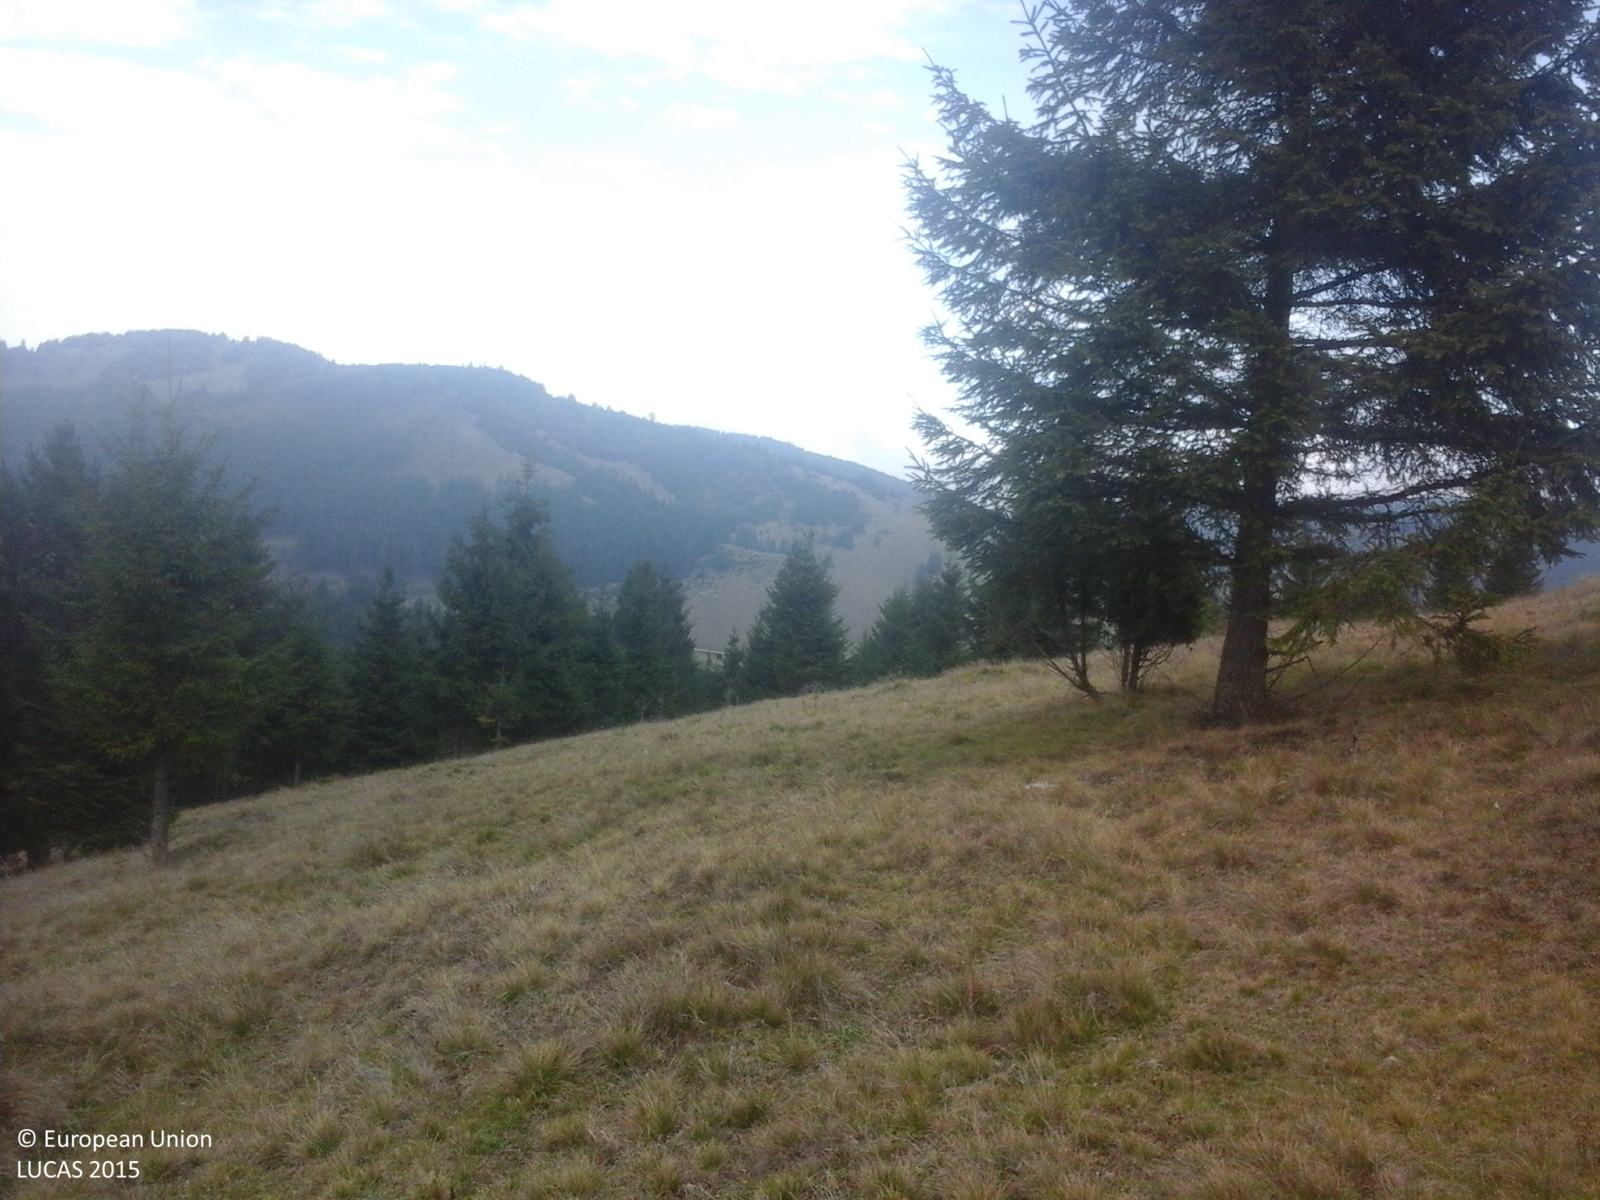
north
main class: Grassland
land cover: Grassland with sparse tree/shrub cover
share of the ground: > 75 %
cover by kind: herbaceous plants 85 %, shrubs 10 %, coniferous forest trees 5 %
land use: Forestry
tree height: > 5 m
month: October
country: RO
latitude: 46.3169
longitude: 26.0824
